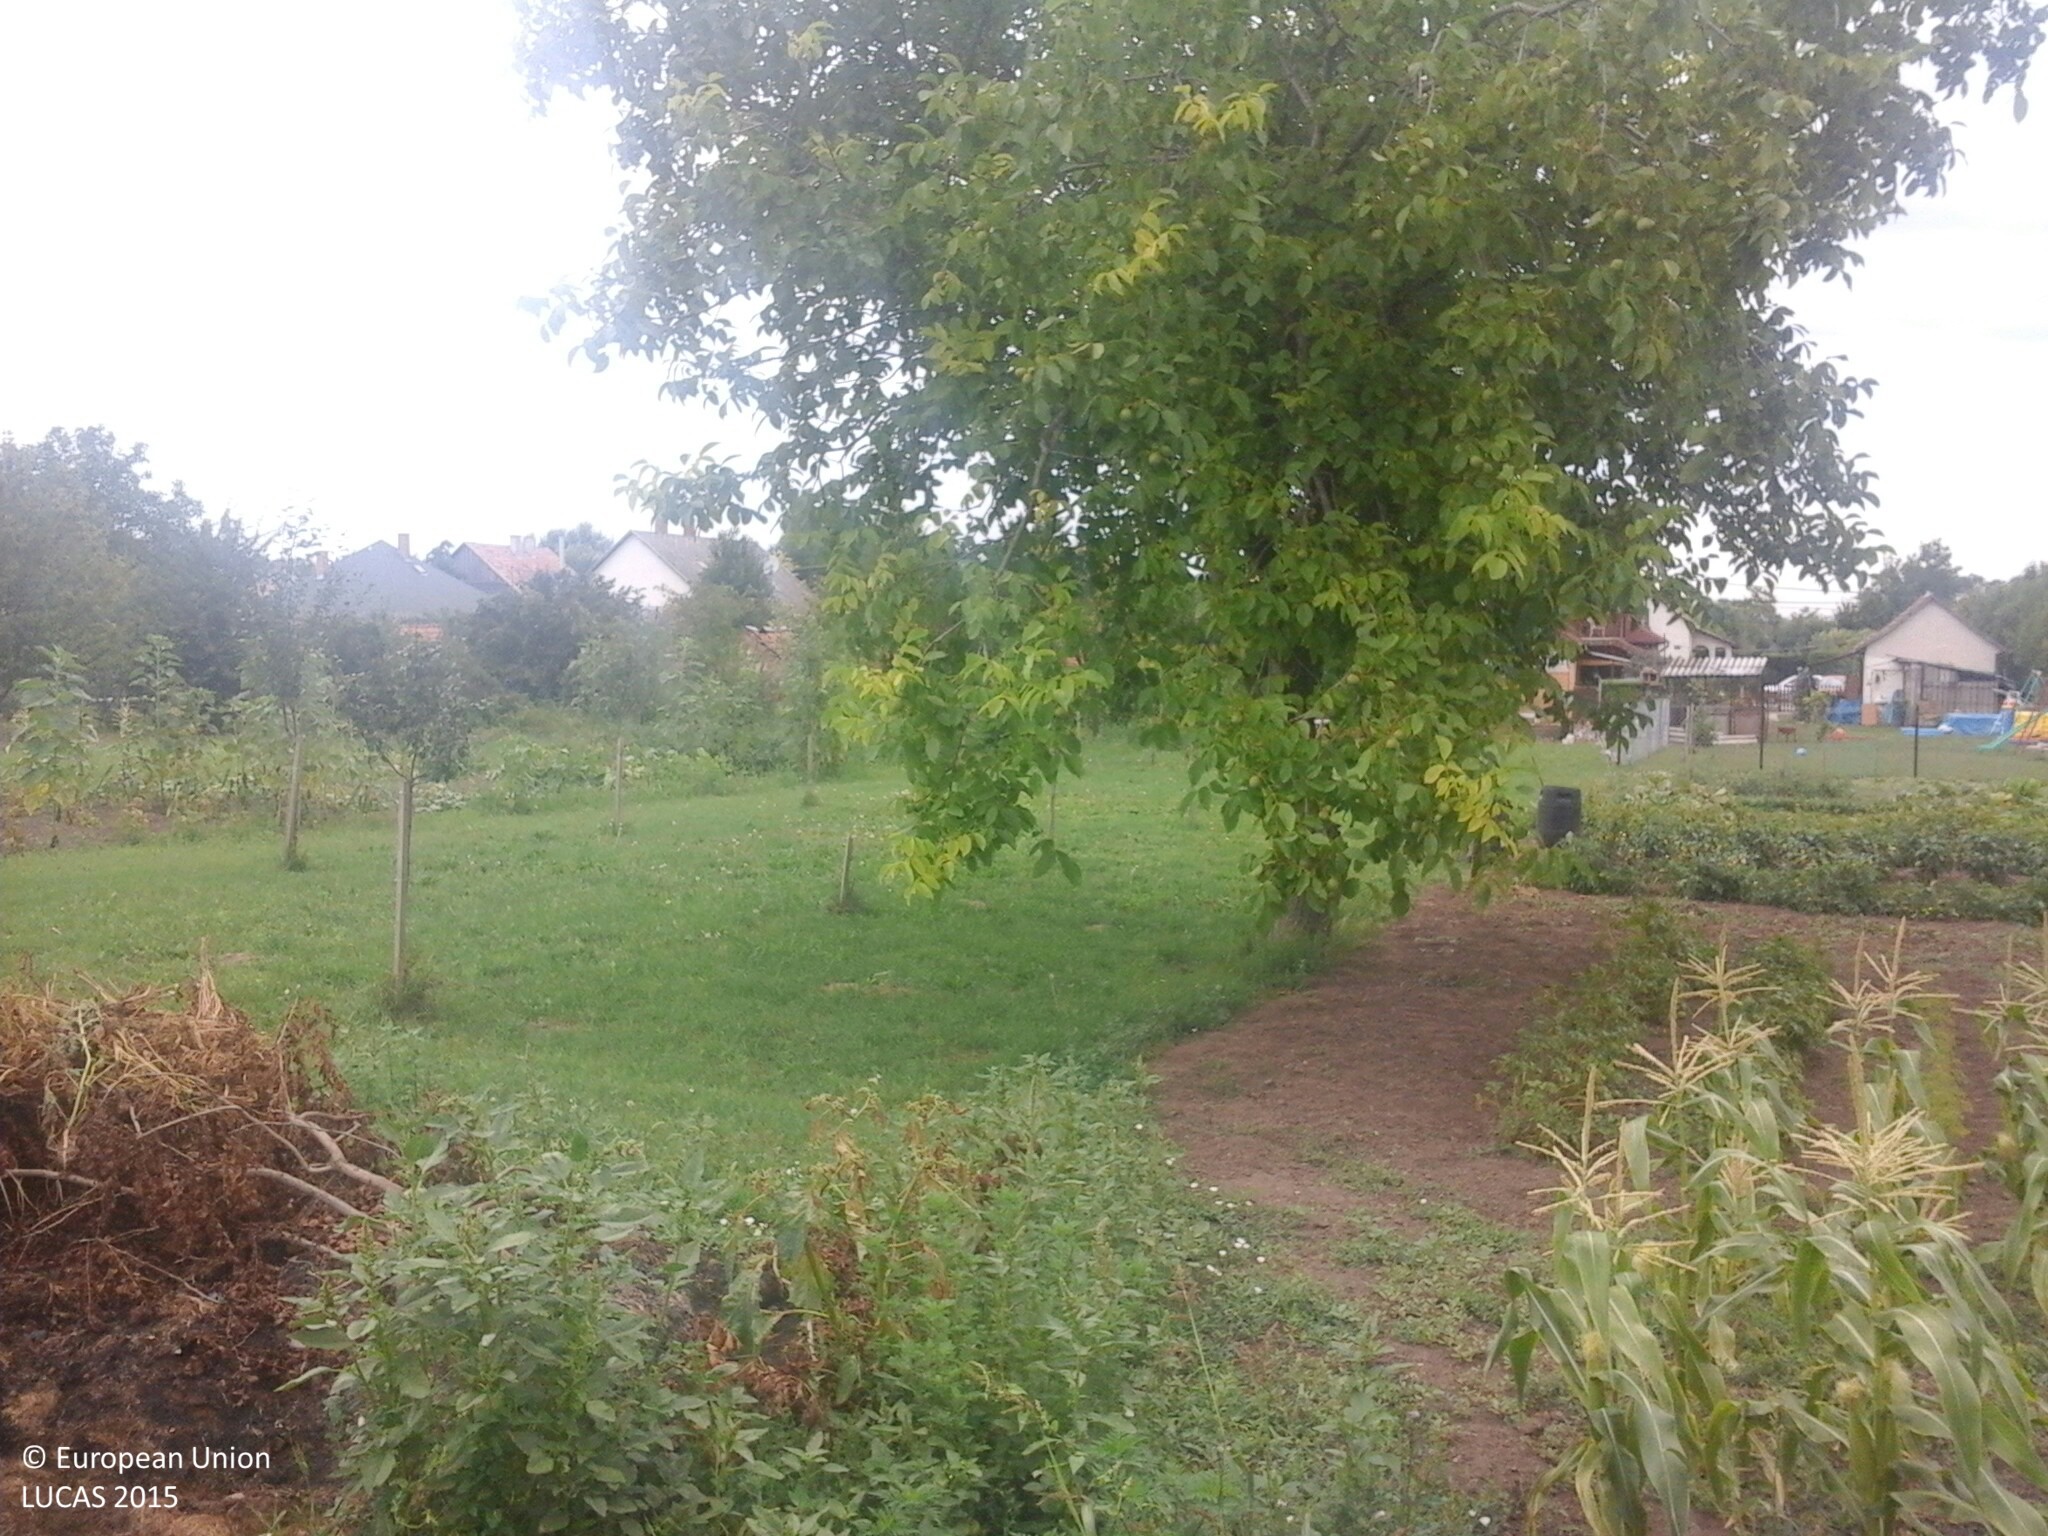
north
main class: Cropland
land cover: Sunflower
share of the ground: > 75 %
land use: Agriculture (excluding fallow land and kitchen gardens)
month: July
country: HU
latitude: 47.0125
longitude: 18.4437
